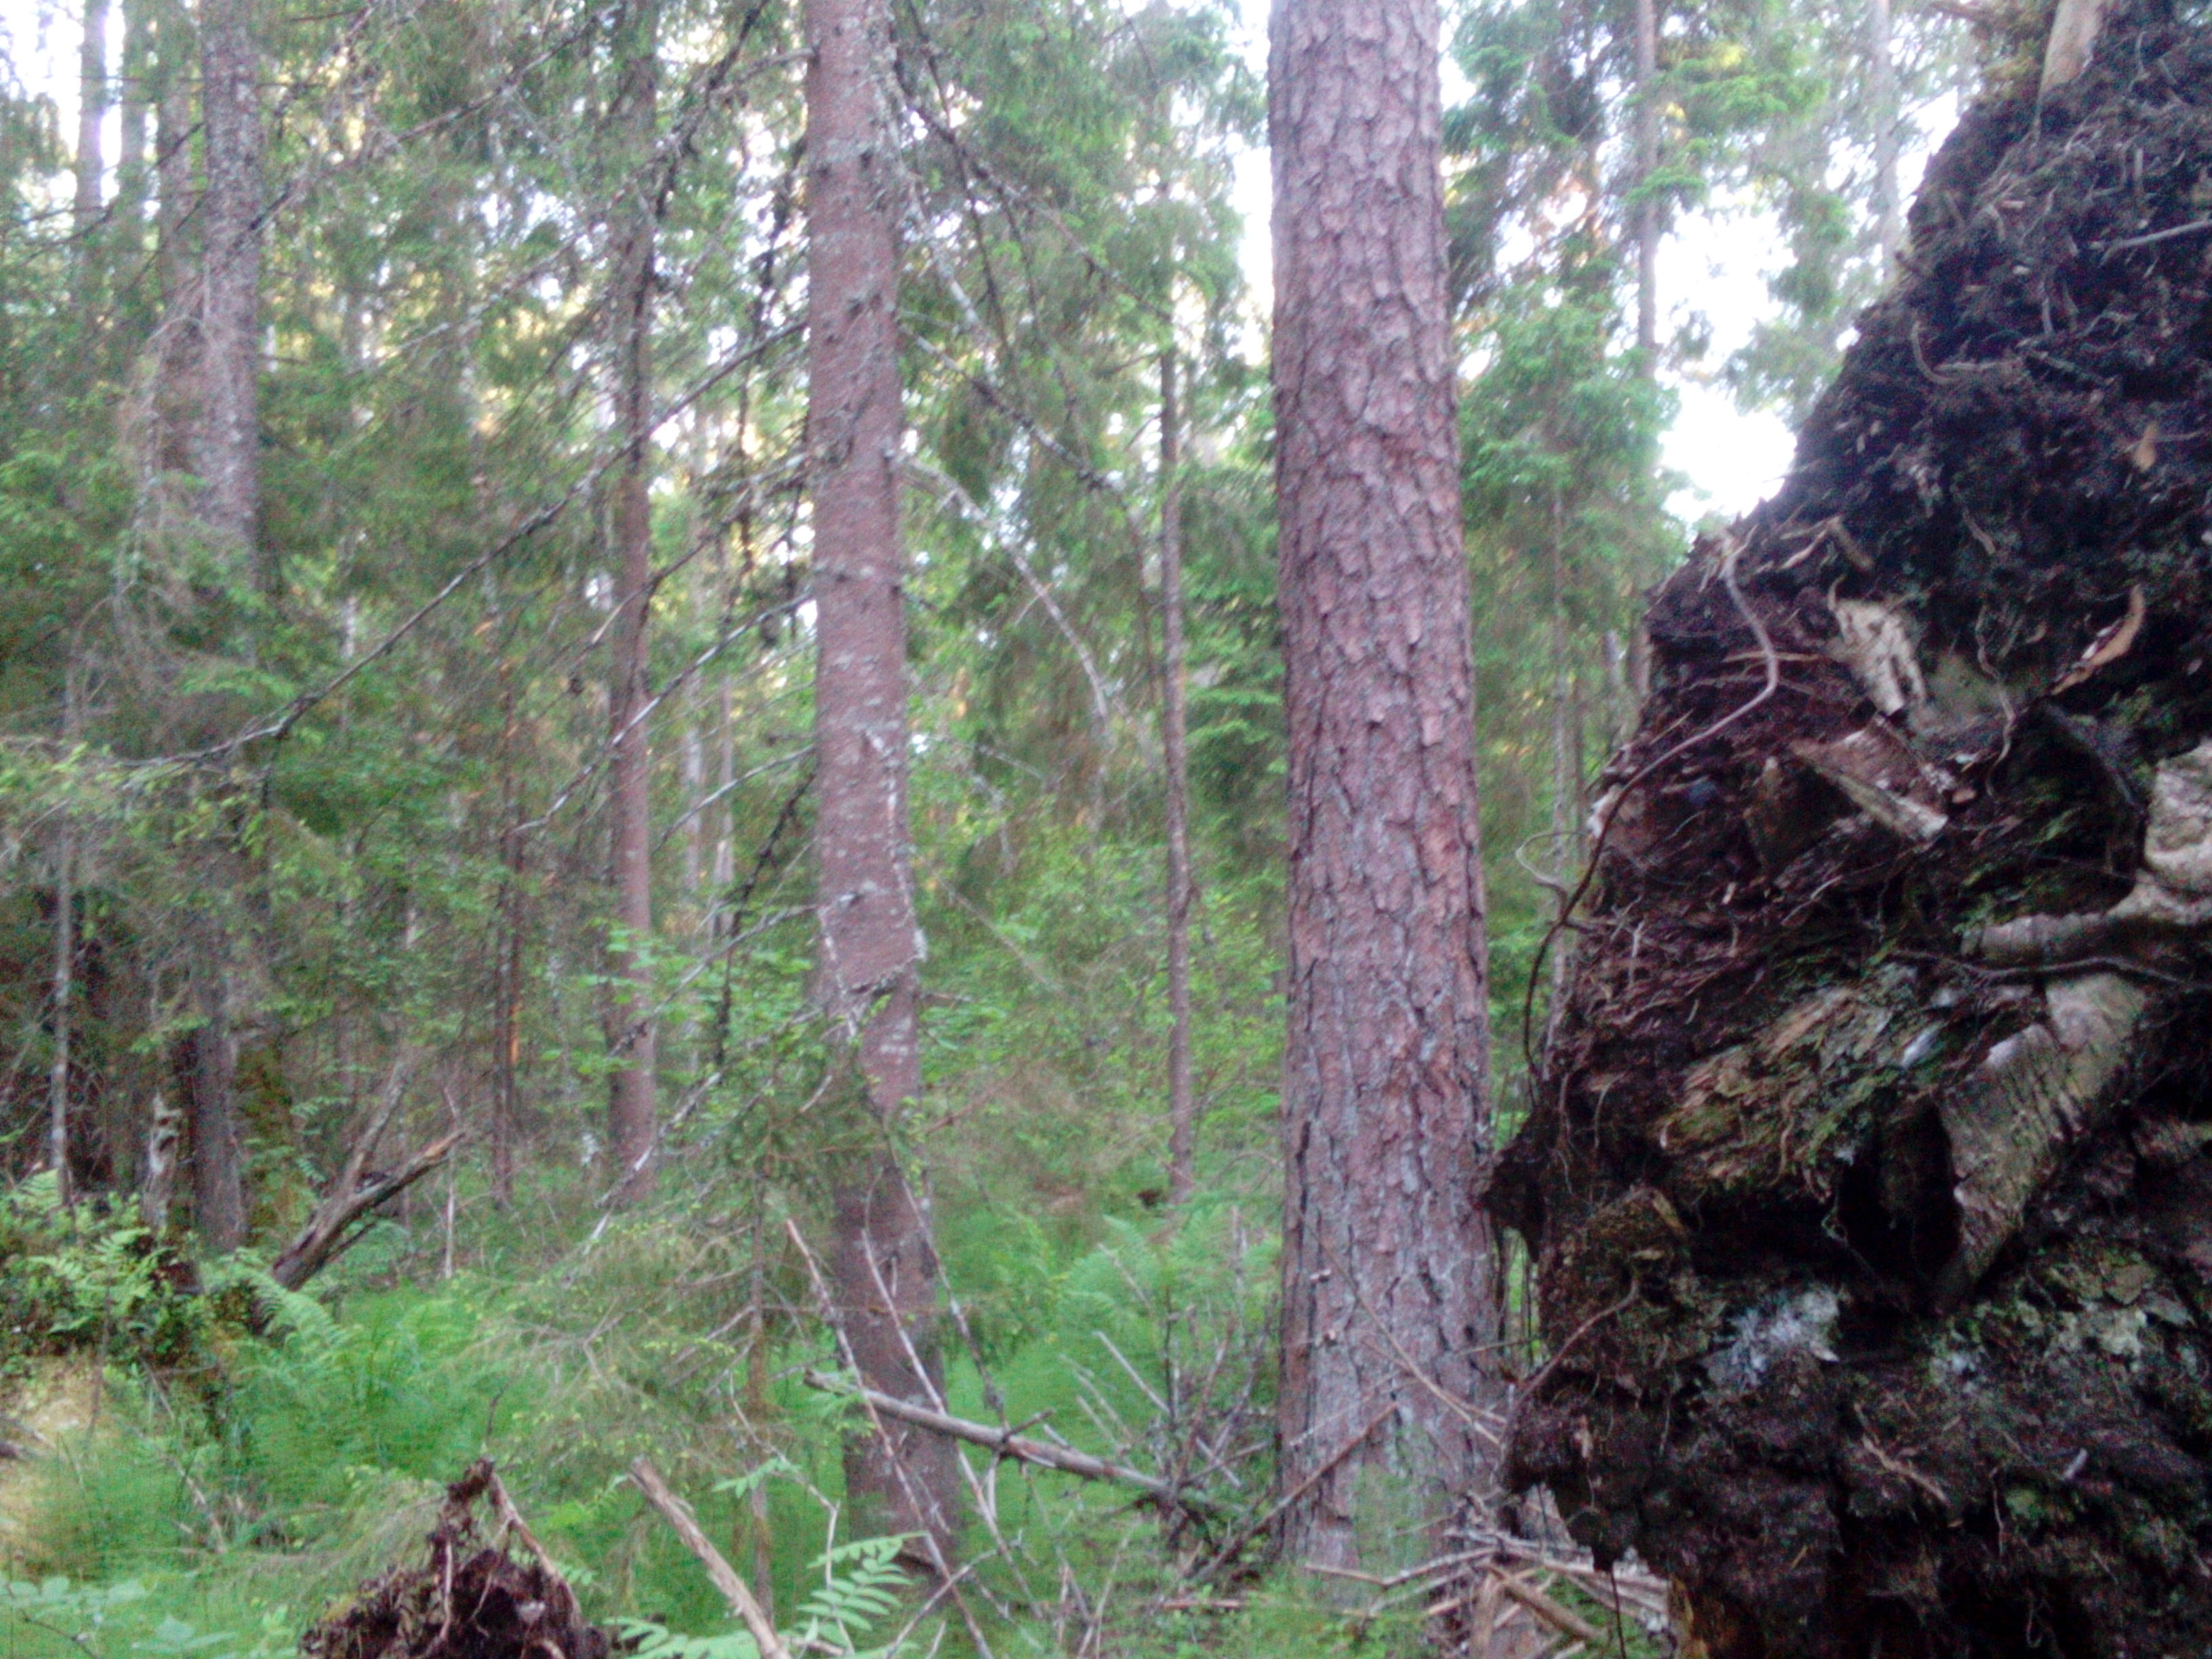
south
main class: Woodland
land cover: Spruce dominated coniferous woodland
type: hemiboreal forest and nemoral coniferous forest and mixed broadleaved-coniferous forest
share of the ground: > 75 %
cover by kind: coniferous forest trees 85 %, broadleaved forest trees 5 %, herbaceous plants 5 %, lichens and mosses 5 %
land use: Forestry
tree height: > 5 m
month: June
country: LV
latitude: 56.7531
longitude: 22.1696
